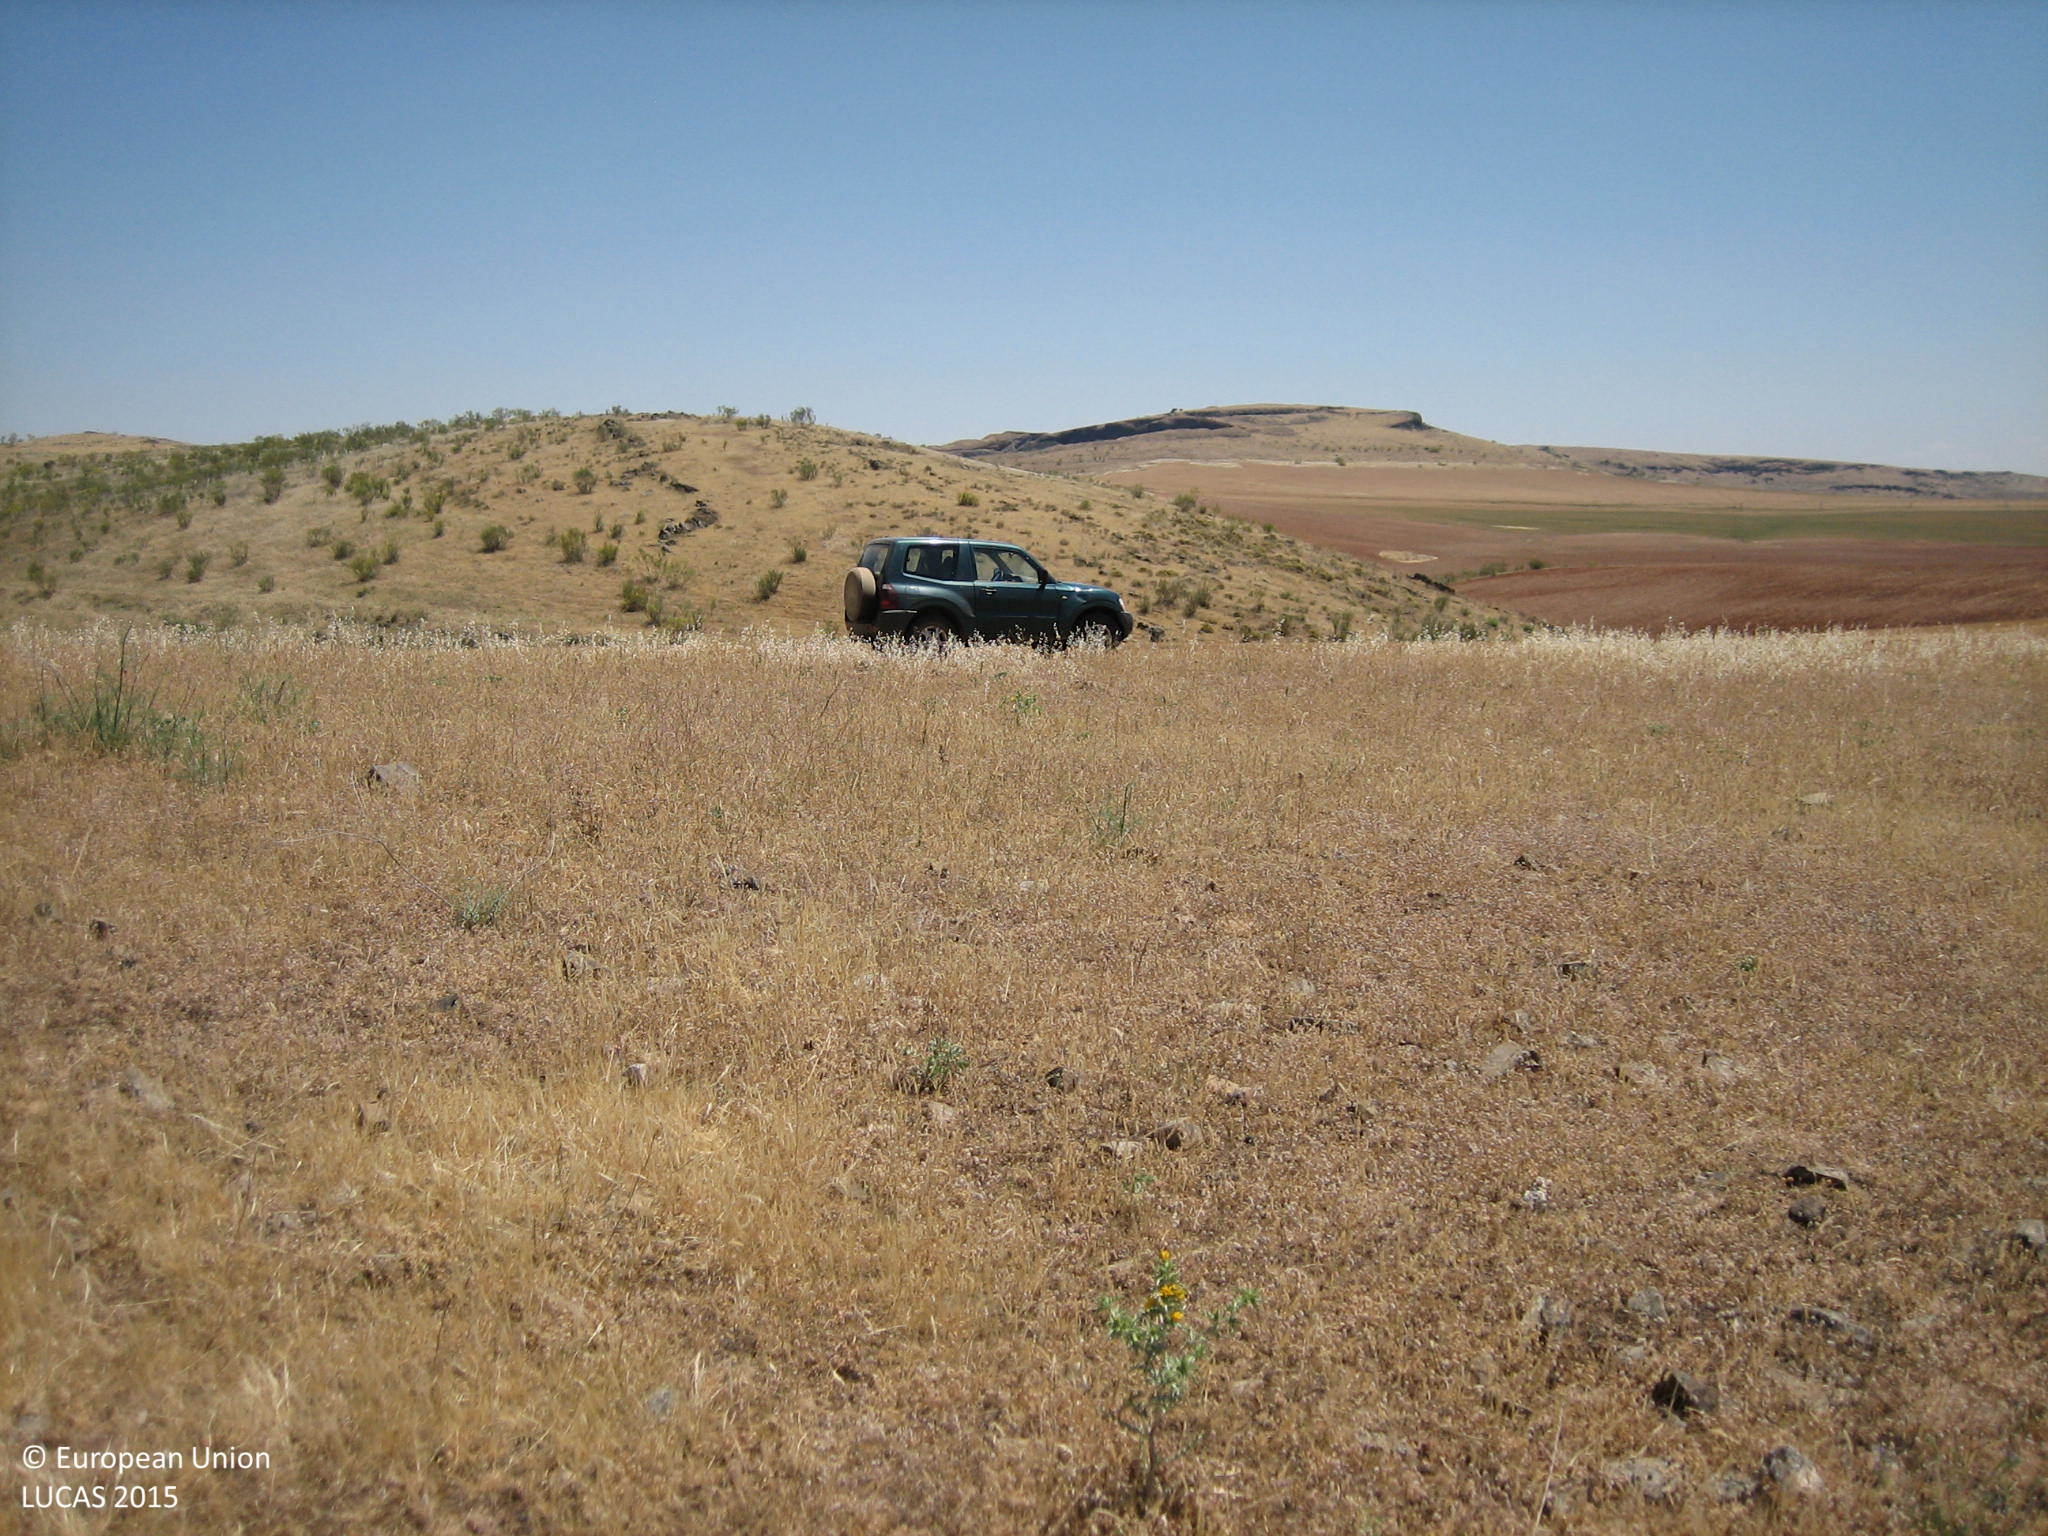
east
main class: Grassland
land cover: Grassland without tree/shrub cover
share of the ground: > 75 %
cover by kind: herbaceous plants 100 %
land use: Agriculture (excluding fallow land and kitchen gardens)
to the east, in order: Grassland without tree/shrub cover; Oats; Grassland without tree/shrub cover; Rock outcrops; Grassland without tree/shrub cover
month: May
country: ES
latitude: 38.9017
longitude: -4.0538
